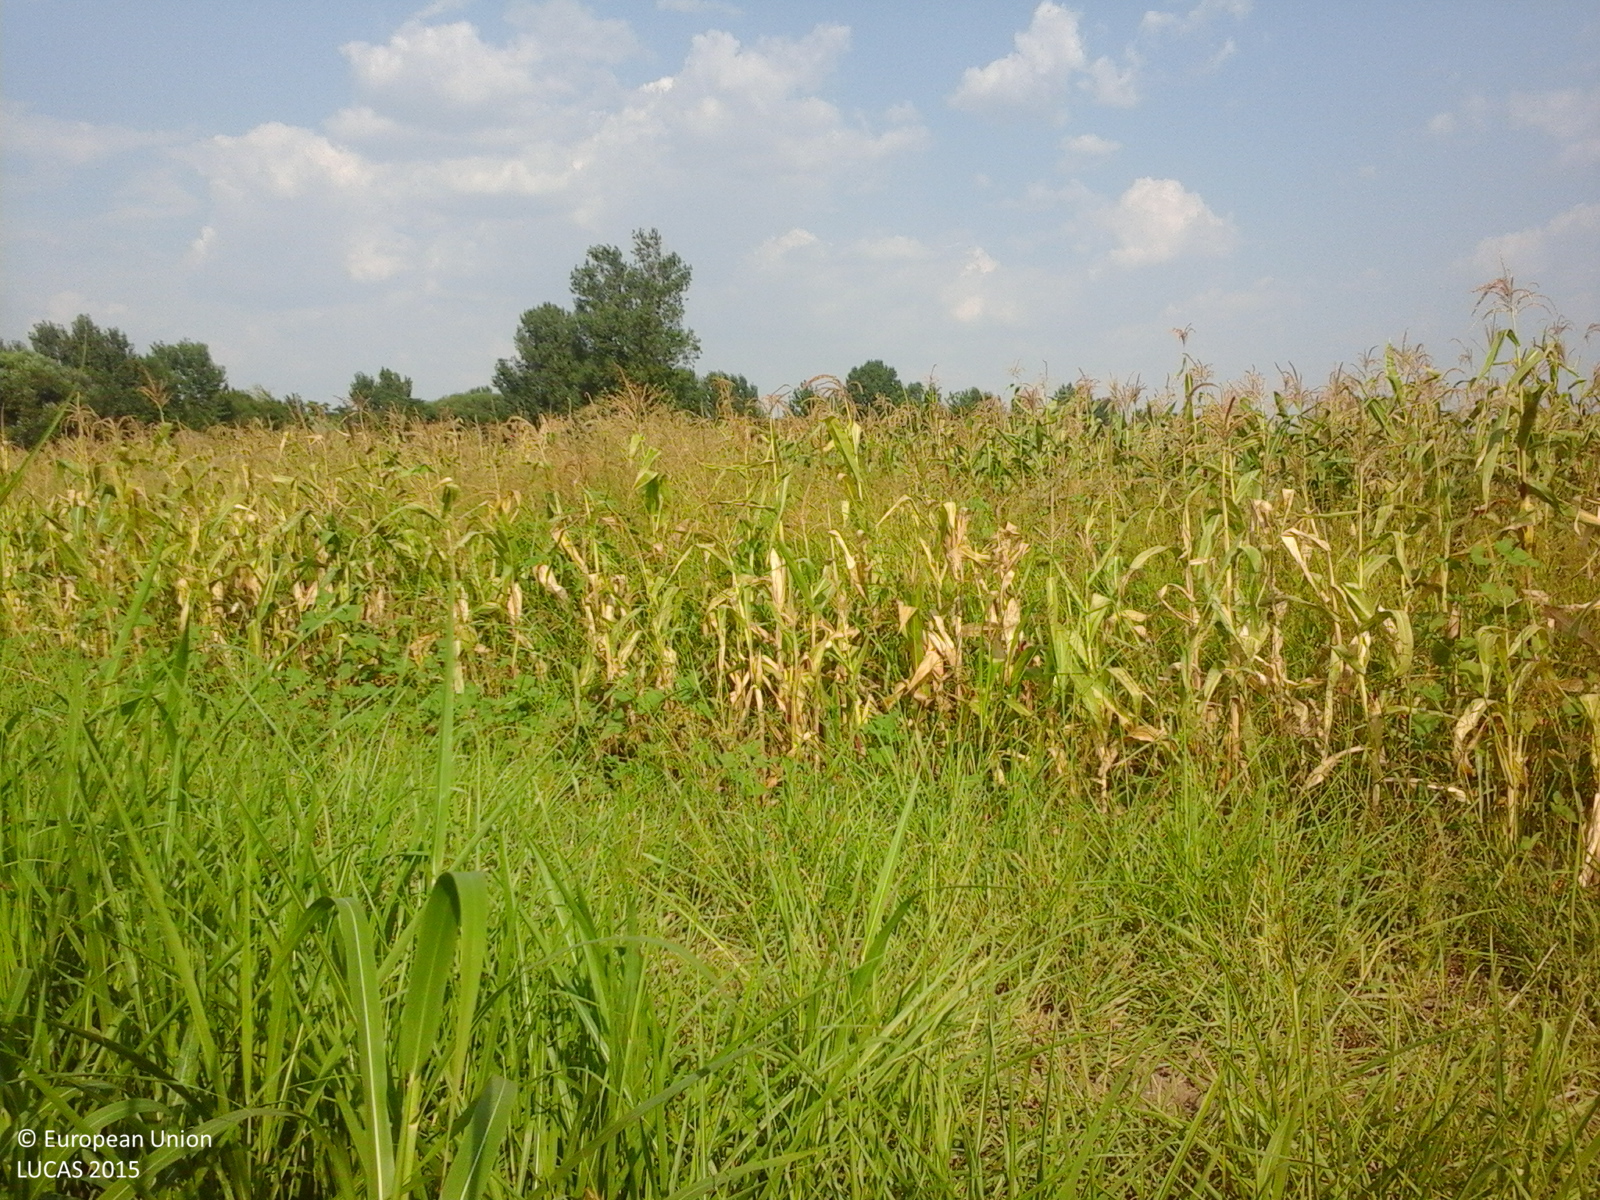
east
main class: Cropland
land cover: Maize
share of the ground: > 75 %
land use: Agriculture (excluding fallow land and kitchen gardens)
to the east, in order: Maize; Spontaneously vegetated surfaces; Maize; Spontaneously vegetated surfaces; Maize; Spontaneously vegetated surfaces; Maize; Grass margins; Rivers and streams; Lines of trees; Maize; Tracks; Grass margins; Maize
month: August
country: RO
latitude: 44.0858
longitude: 23.0691
